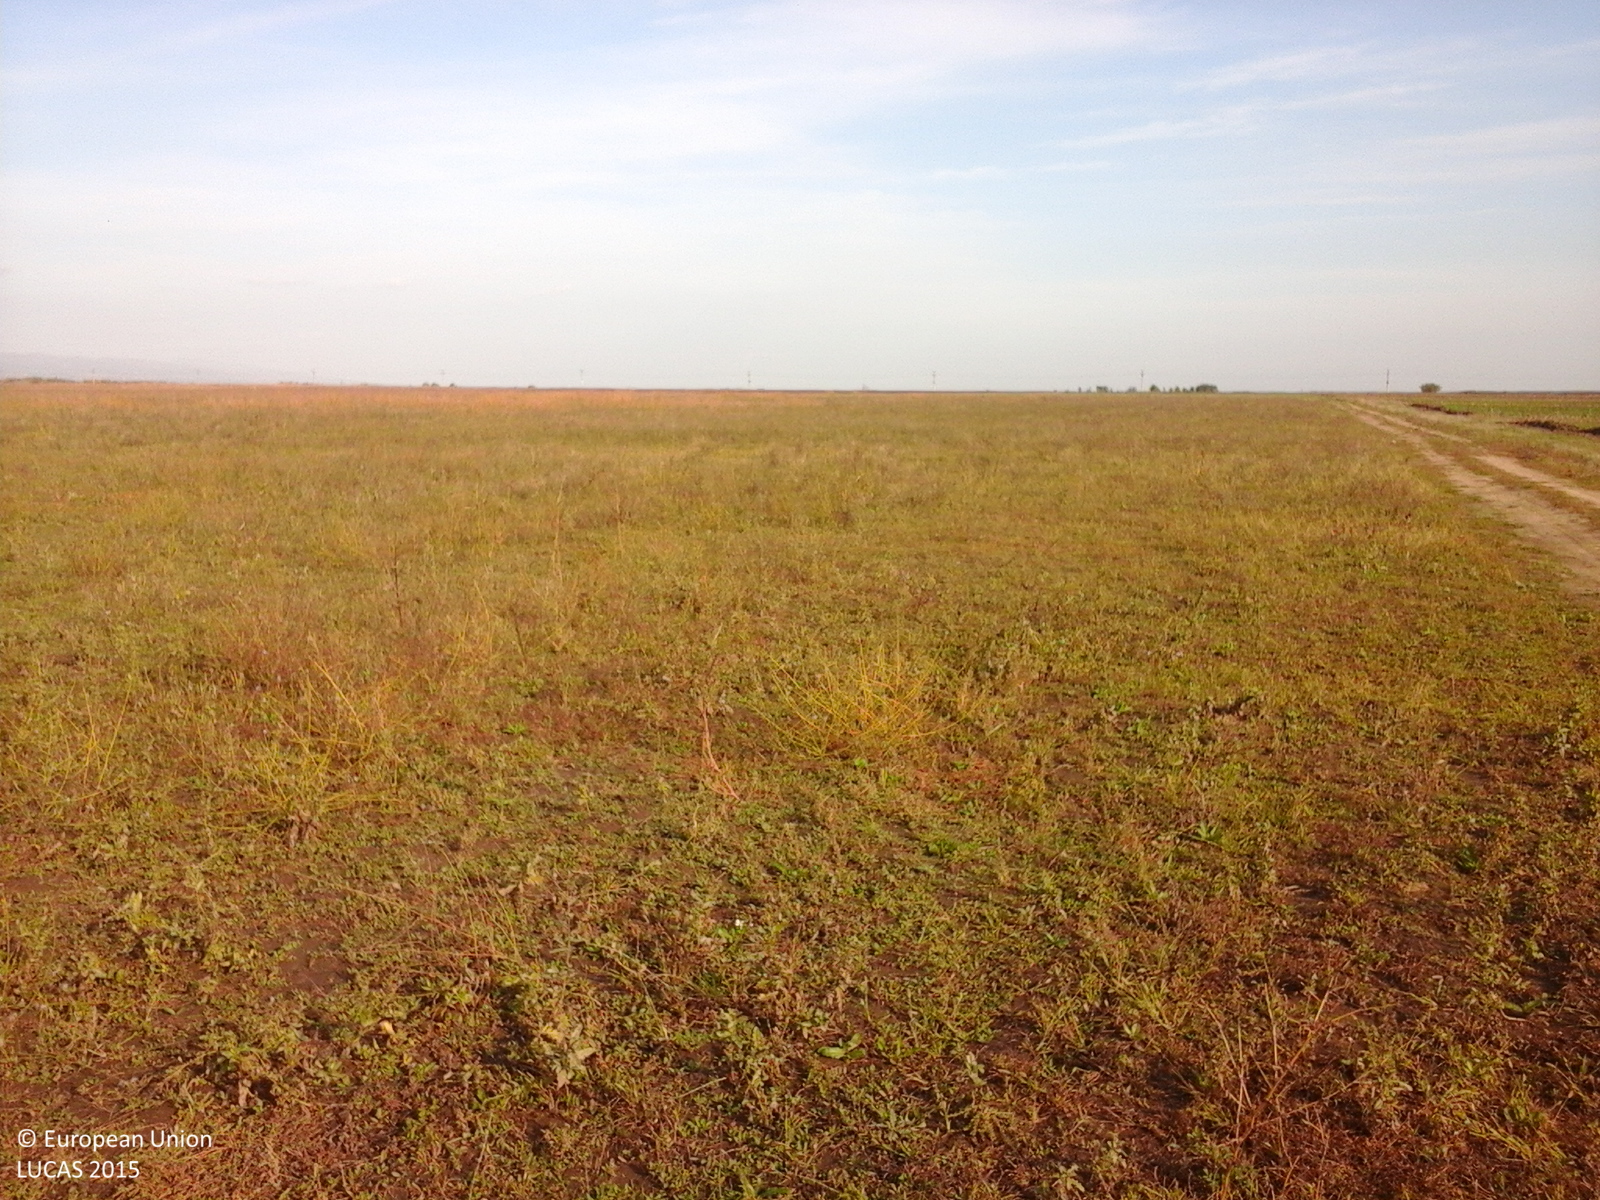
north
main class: Grassland
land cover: Spontaneously vegetated surfaces
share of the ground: > 75 %
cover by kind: herbaceous plants 100 %
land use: Fallow land
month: October
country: RO
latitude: 45.5258
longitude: 27.1333
